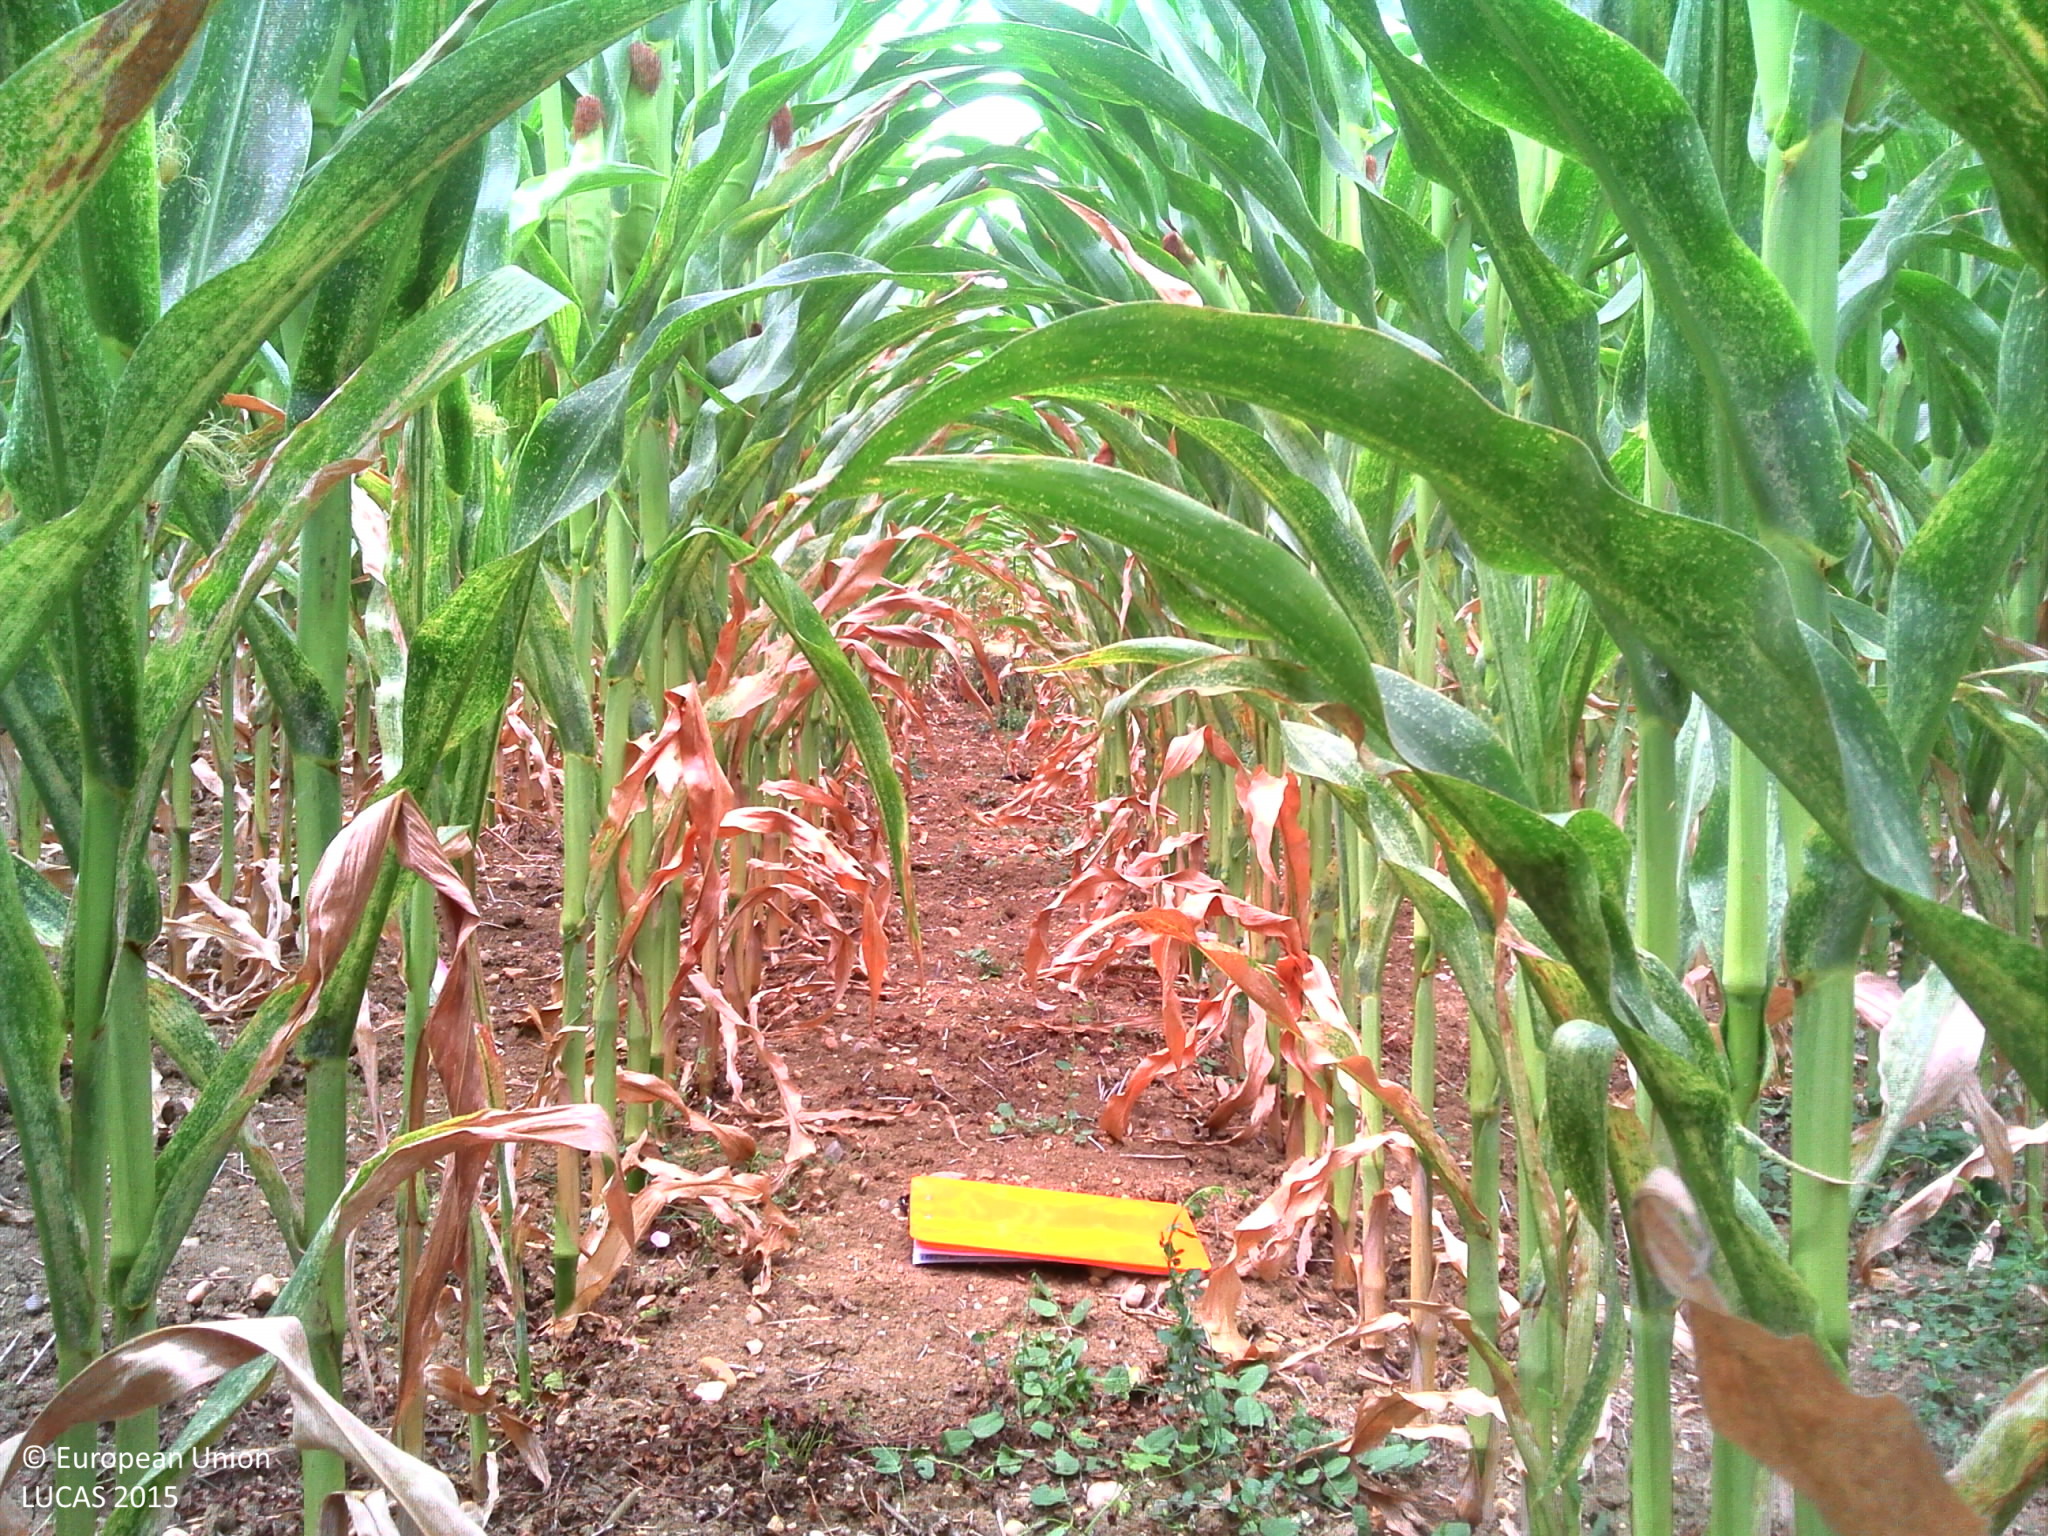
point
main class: Cropland
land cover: Maize
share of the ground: > 75 %
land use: Agriculture (excluding fallow land and kitchen gardens)
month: July
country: FR
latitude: 44.0878
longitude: 0.6158
